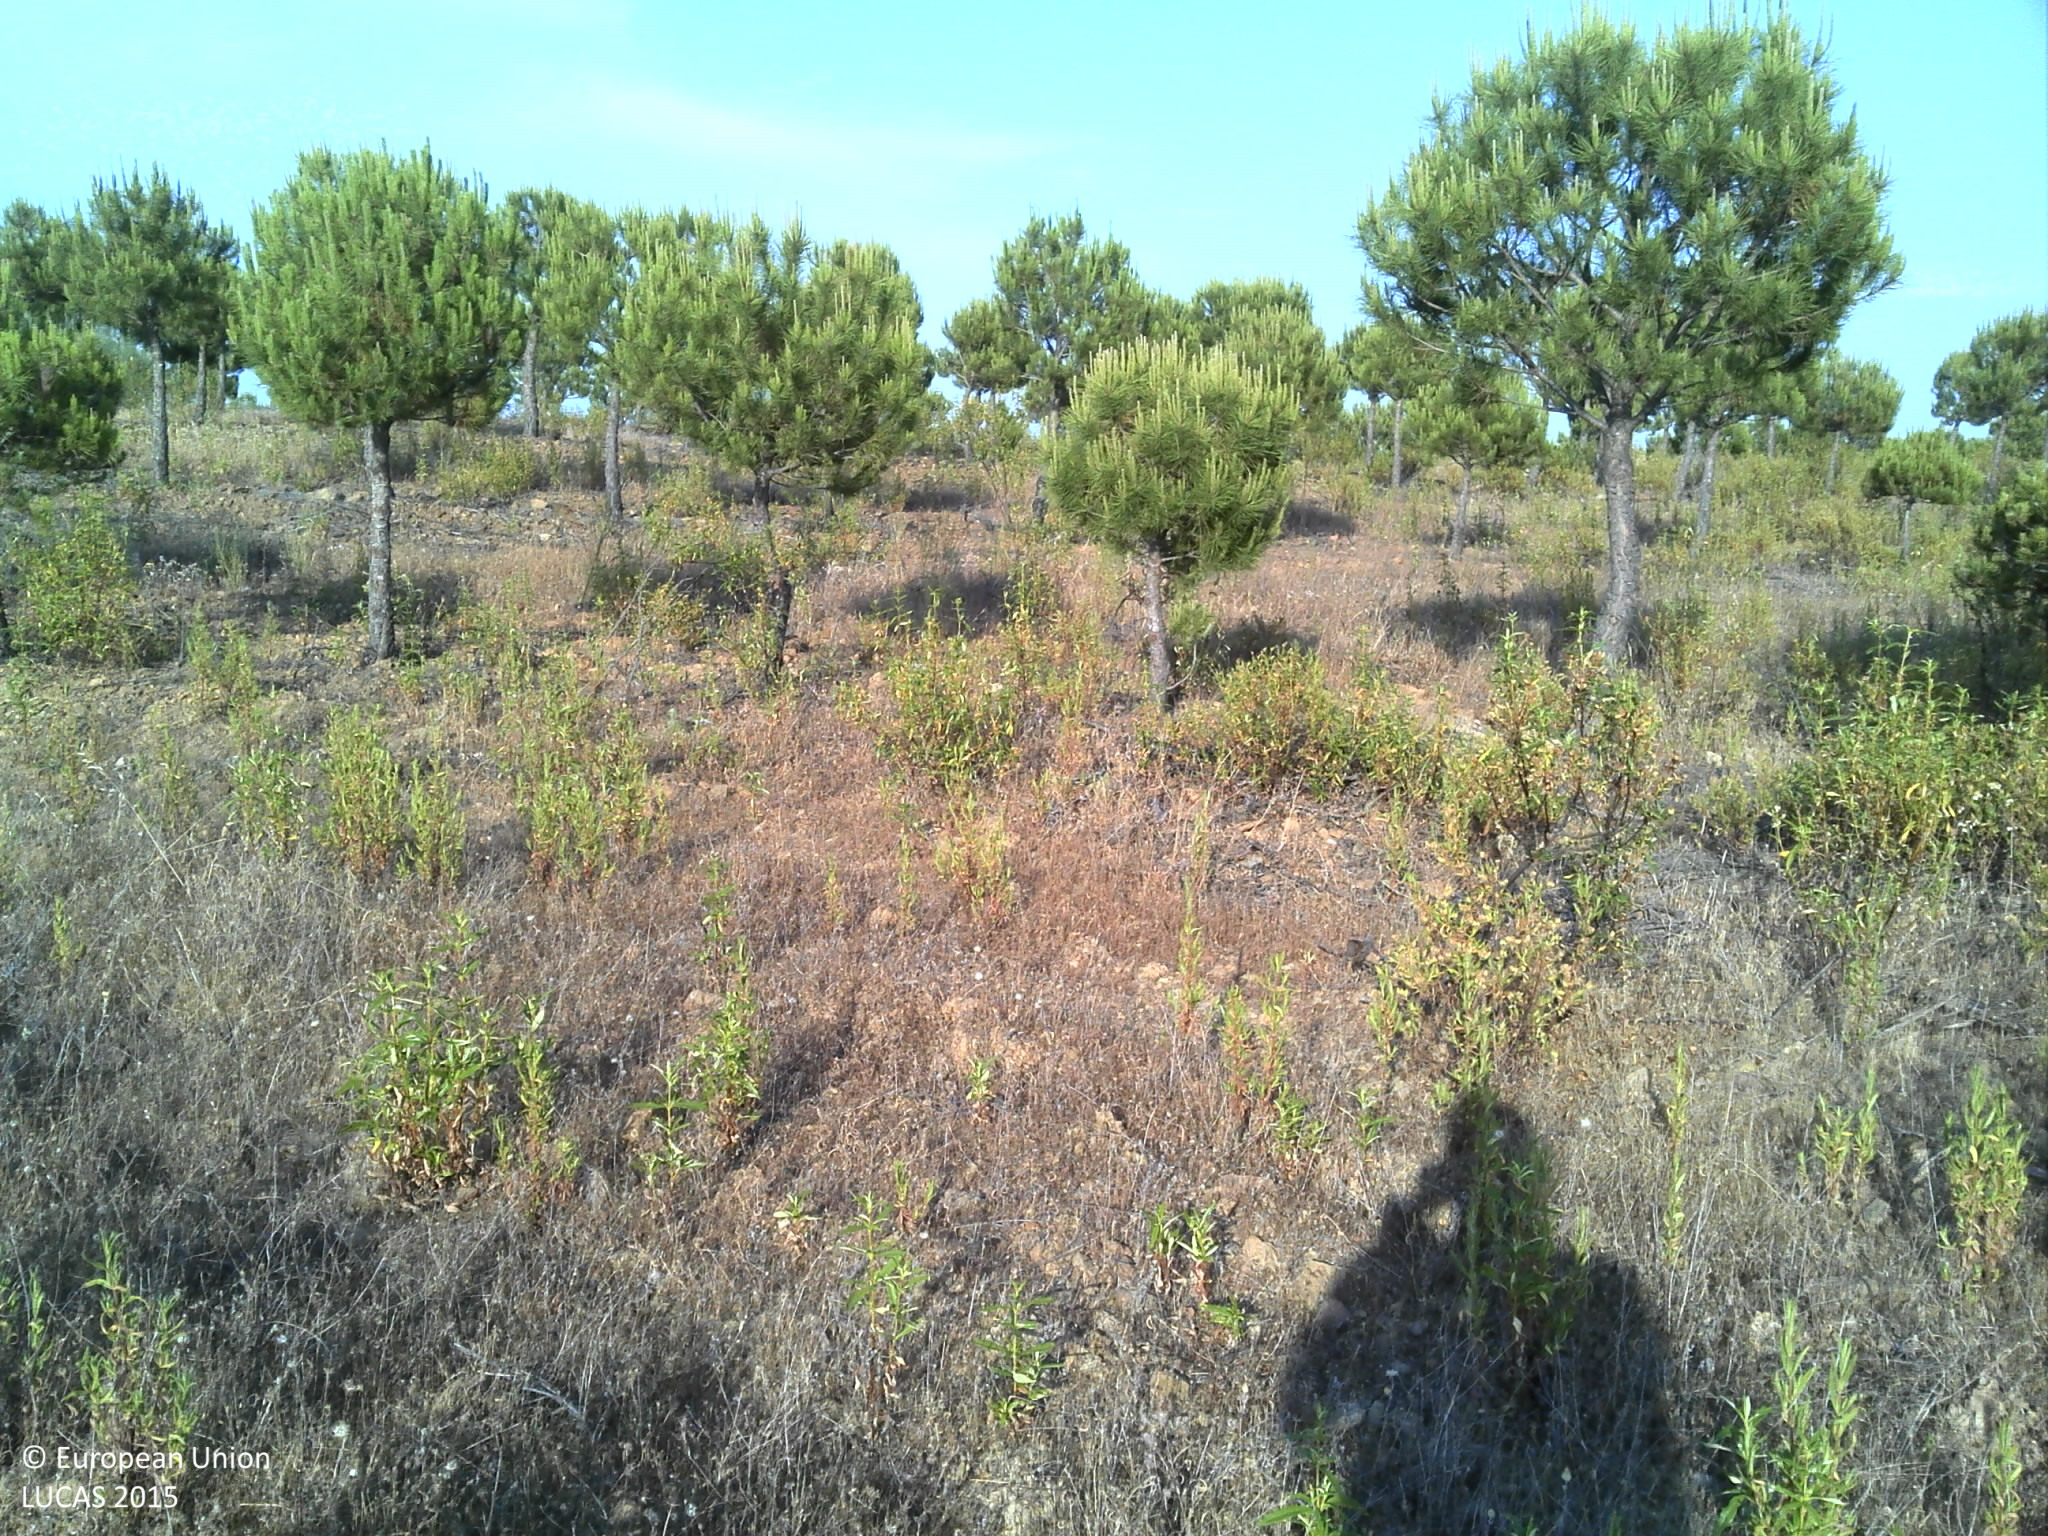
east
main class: Woodland
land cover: Pine dominated coniferous woodland
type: coniferous forest of the mediterranean region
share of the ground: 10 - 25 %
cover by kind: herbaceous plants 50 %, coniferous forest trees 25 %, shrubs 25 %
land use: Forestry
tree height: < 5 m
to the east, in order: Pine dominated coniferous woodland; Tracks; Pine dominated coniferous woodland
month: May
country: PT
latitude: 37.4334
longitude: -7.7453
